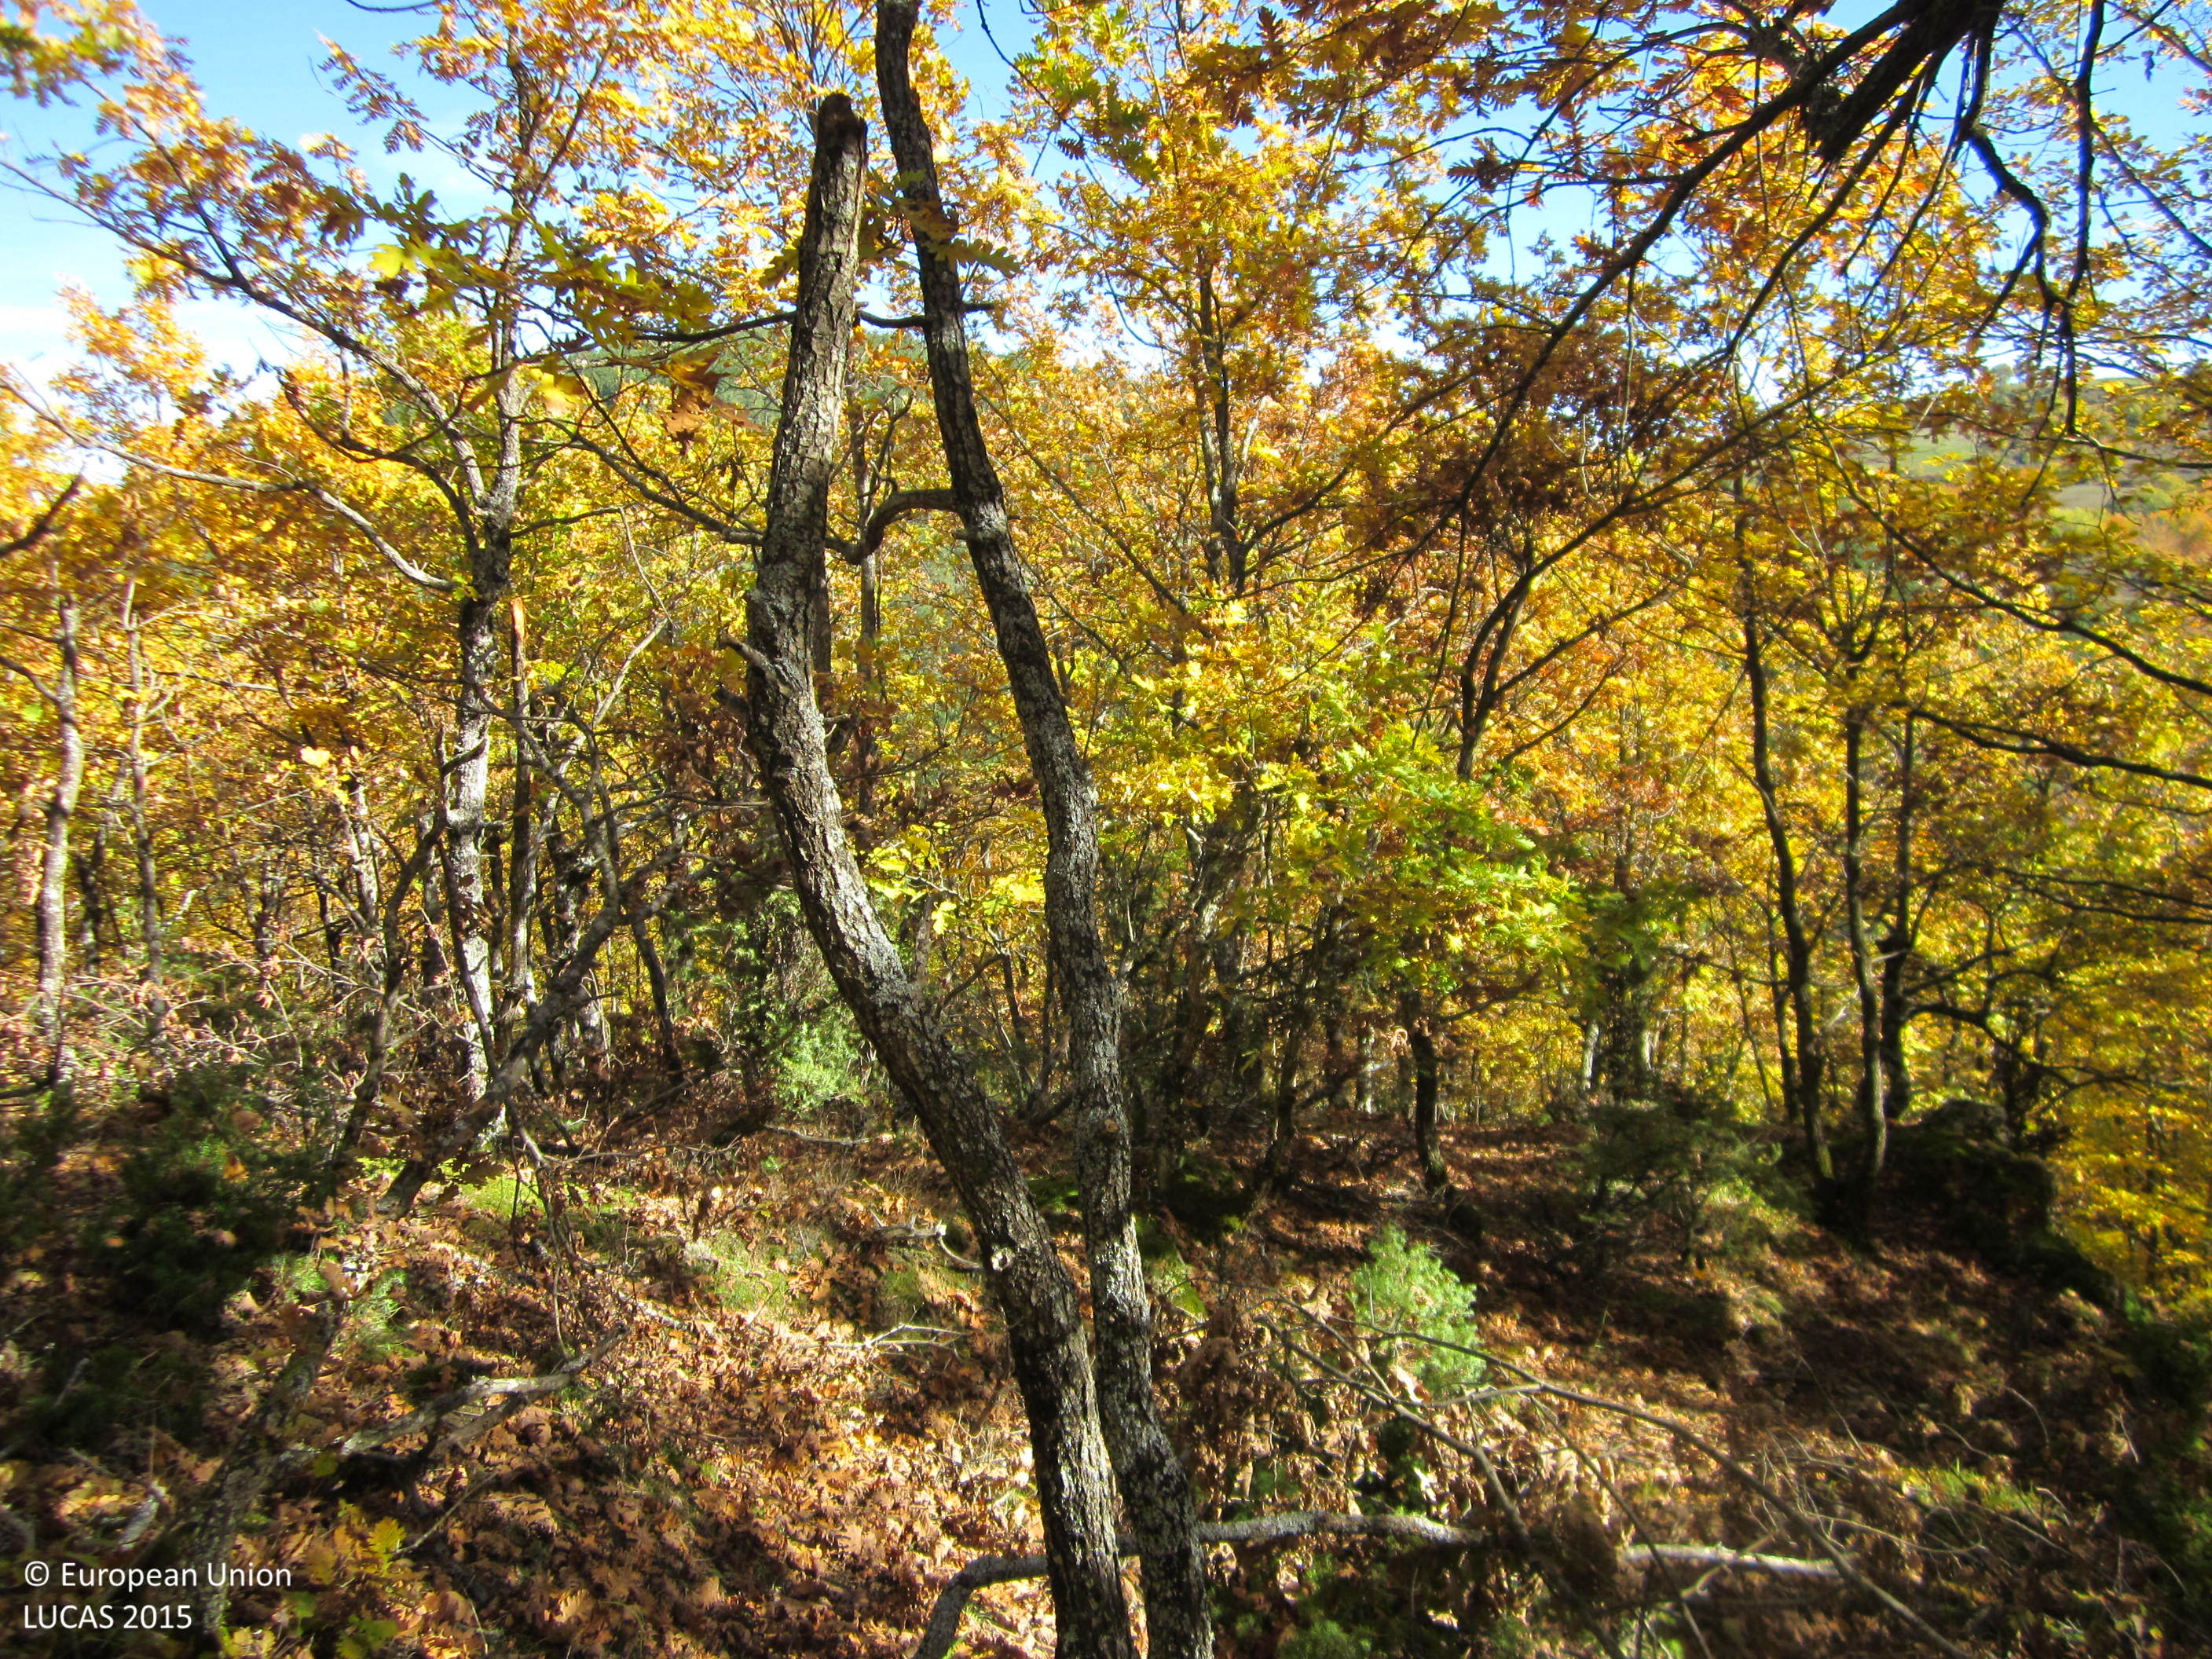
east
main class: Woodland
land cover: Broadleaved woodland
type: mesophytic deciduous forest
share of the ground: > 75 %
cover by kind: broadleaved forest trees 80 %, shrubs 5 %, herbaceous plants 5 %, lichens and mosses 5 %, unconsolidated bare surface 5 %
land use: Forestry
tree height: > 5 m
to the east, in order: Broadleaved woodland; Rivers and streams; Pine dominated coniferous woodland; Broadleaved woodland
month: November
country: BG
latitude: 41.3365
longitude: 25.6524
